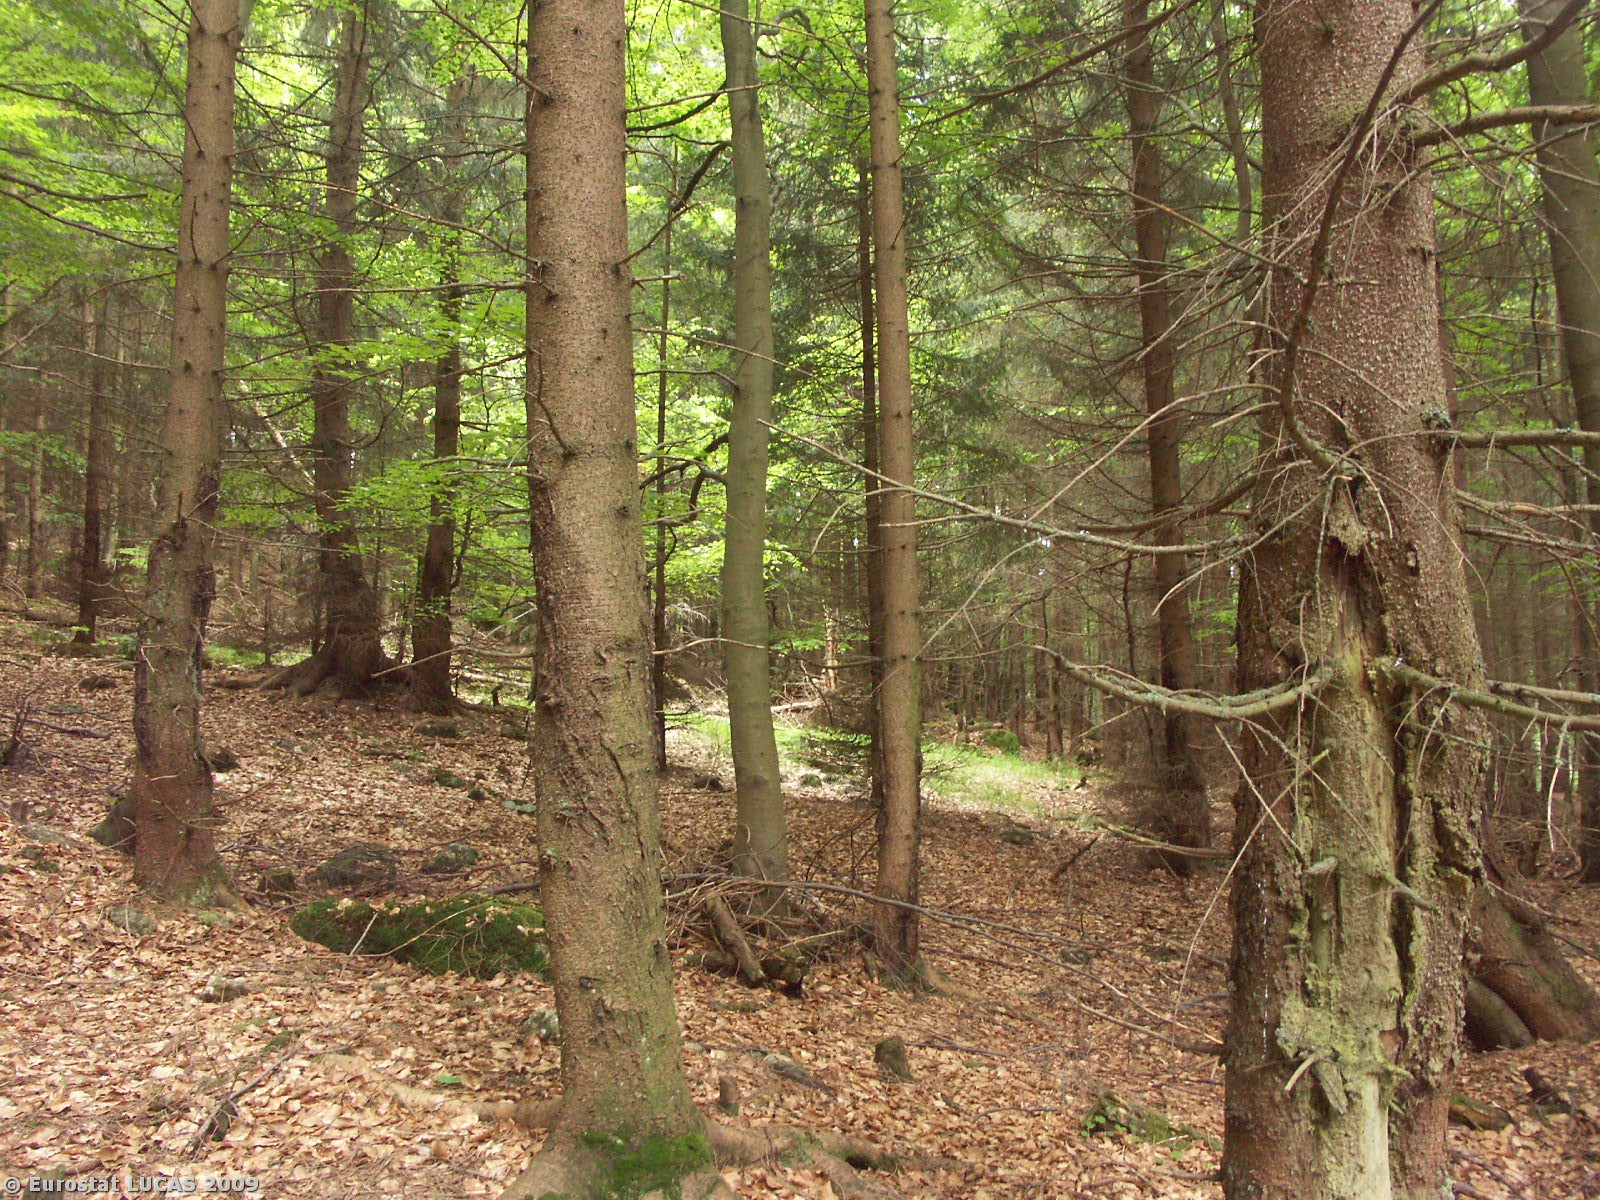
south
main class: Woodland
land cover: Mixed woodland
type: mountainous beech forest
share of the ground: > 75 %
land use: Forestry
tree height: > 5 m
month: May
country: CZ
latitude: 48.6120
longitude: 14.6534
